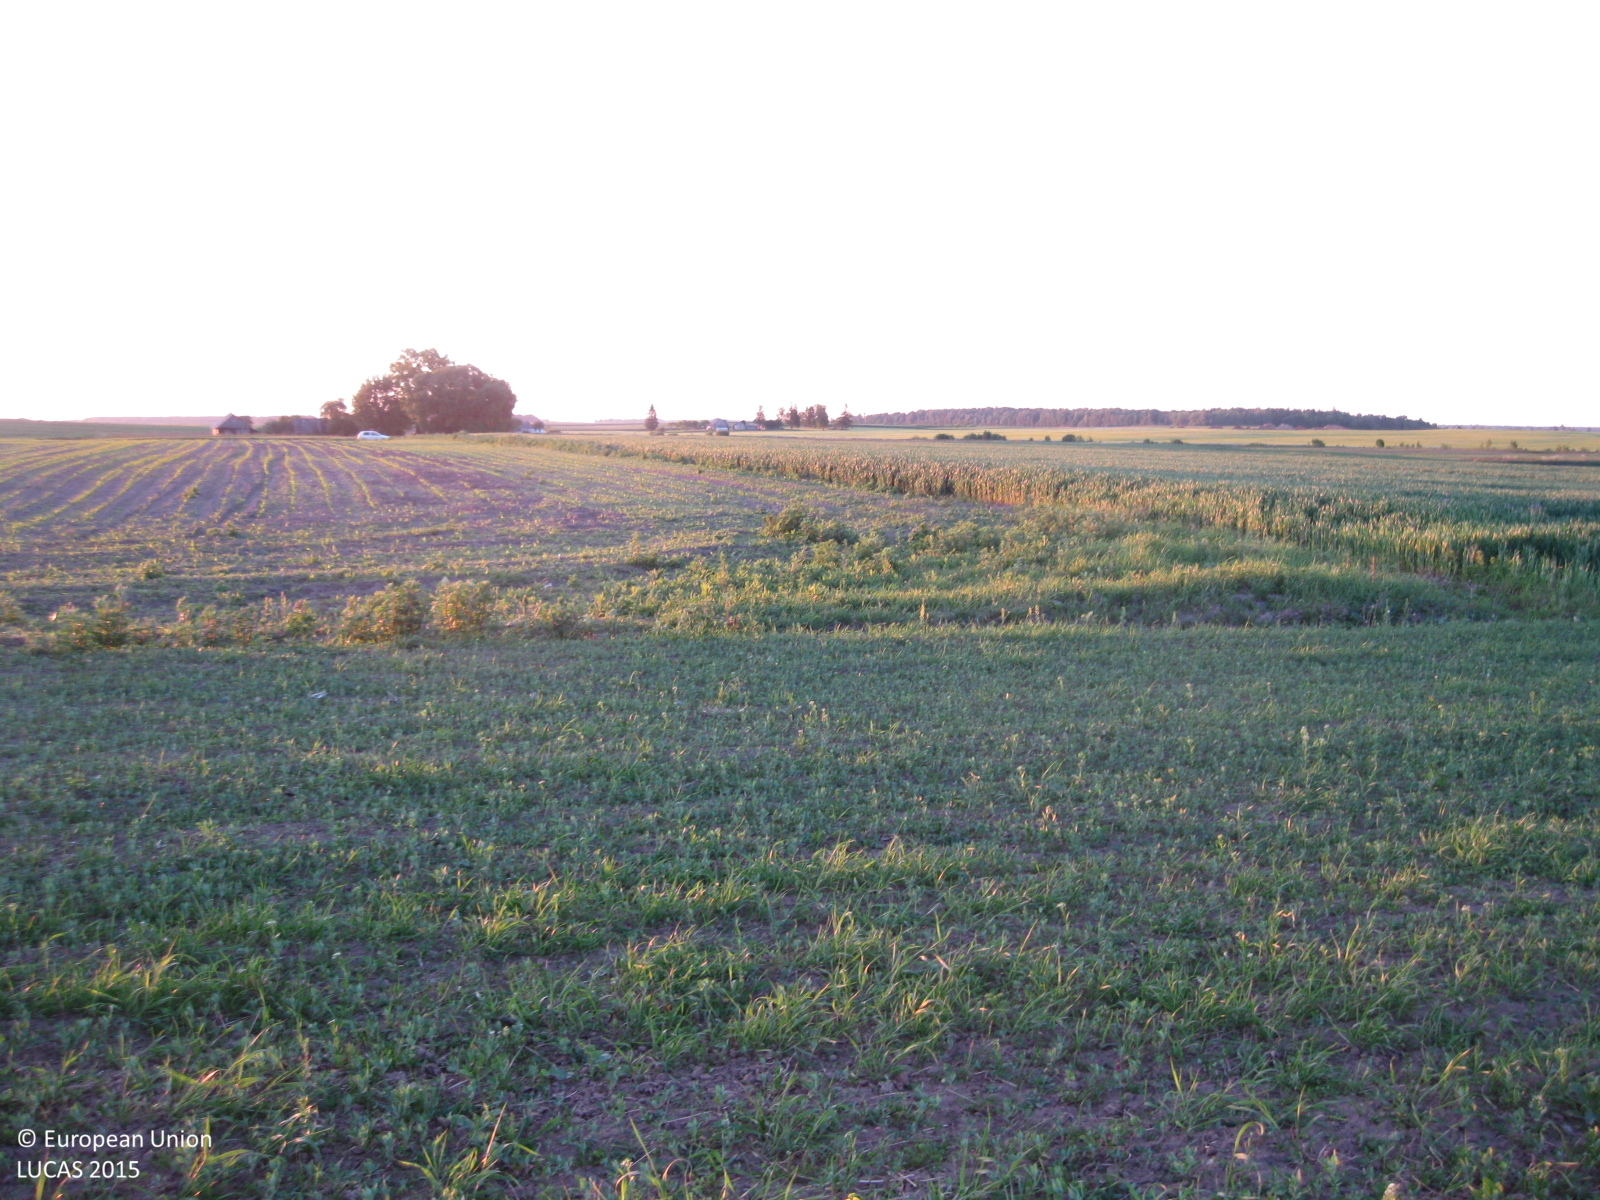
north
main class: Cropland
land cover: Rape and turnip rape
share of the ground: 25 - 50 %
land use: Agriculture (excluding fallow land and kitchen gardens)
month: June
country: LT
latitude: 55.5049
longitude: 23.6829
